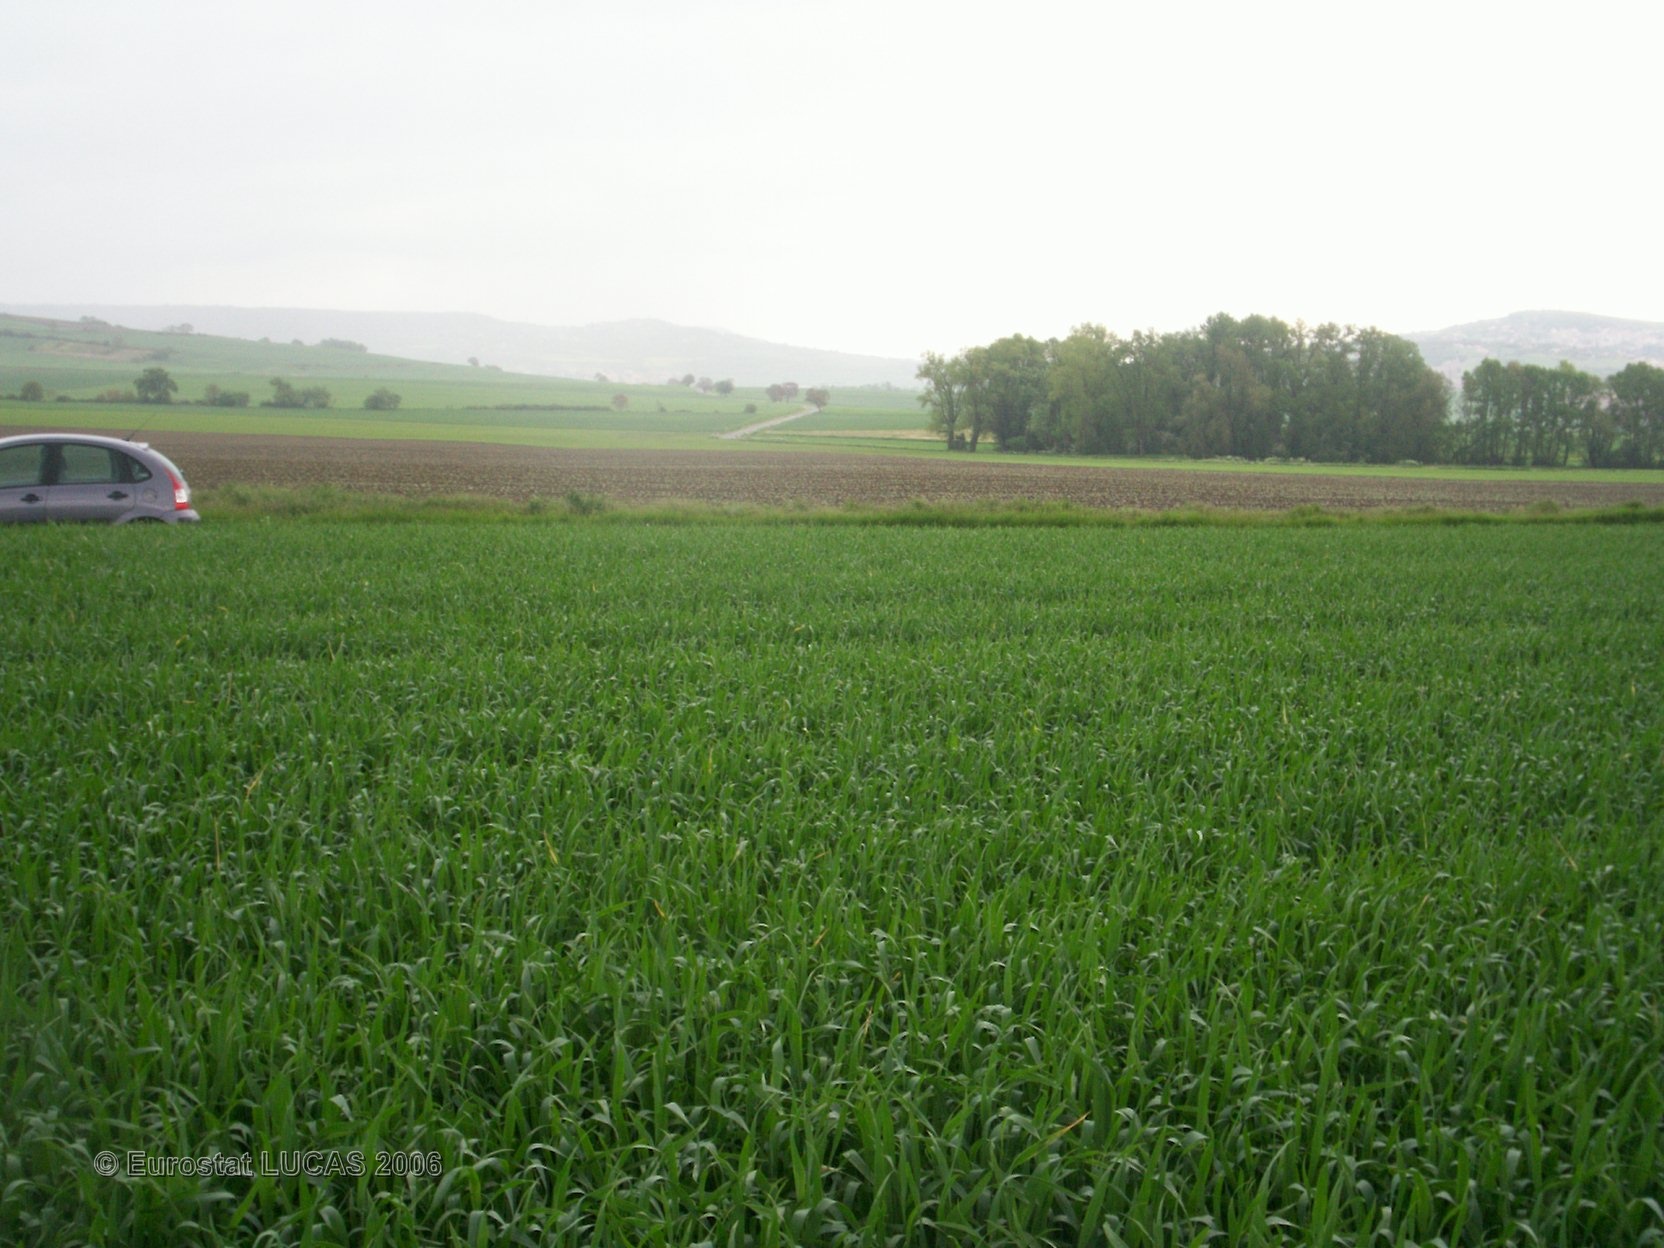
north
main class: Cropland
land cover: Common wheat
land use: Agriculture (excluding fallow land and kitchen gardens)
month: May
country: FR
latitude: 45.6425
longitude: 3.1362
